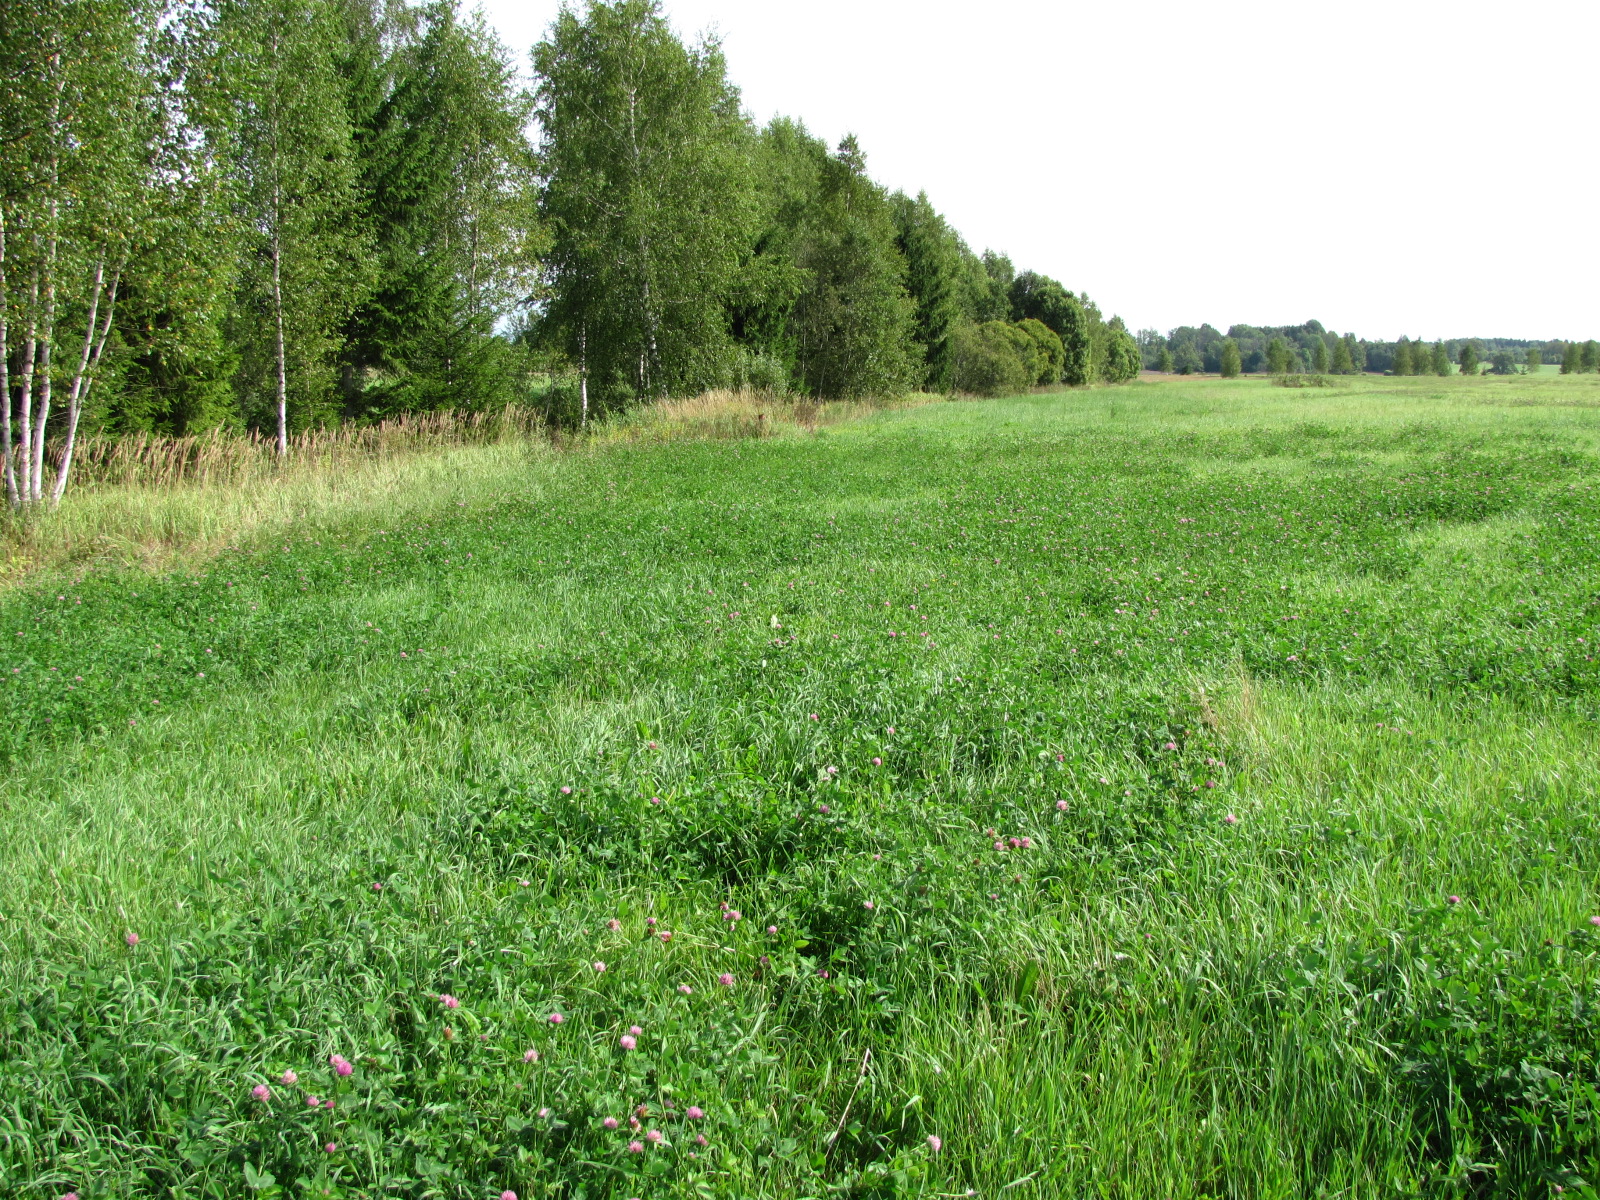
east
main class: Cropland
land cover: Clovers
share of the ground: > 75 %
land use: Agriculture (excluding fallow land and kitchen gardens)
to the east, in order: Clovers; Electric lines; Clovers; Shruby margins; Abandoned hedges; Ditches and canals; Abandoned hedges; Grassland without tree/shrub cover; Barley
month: August
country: LV
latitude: 56.8952
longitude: 25.2984
